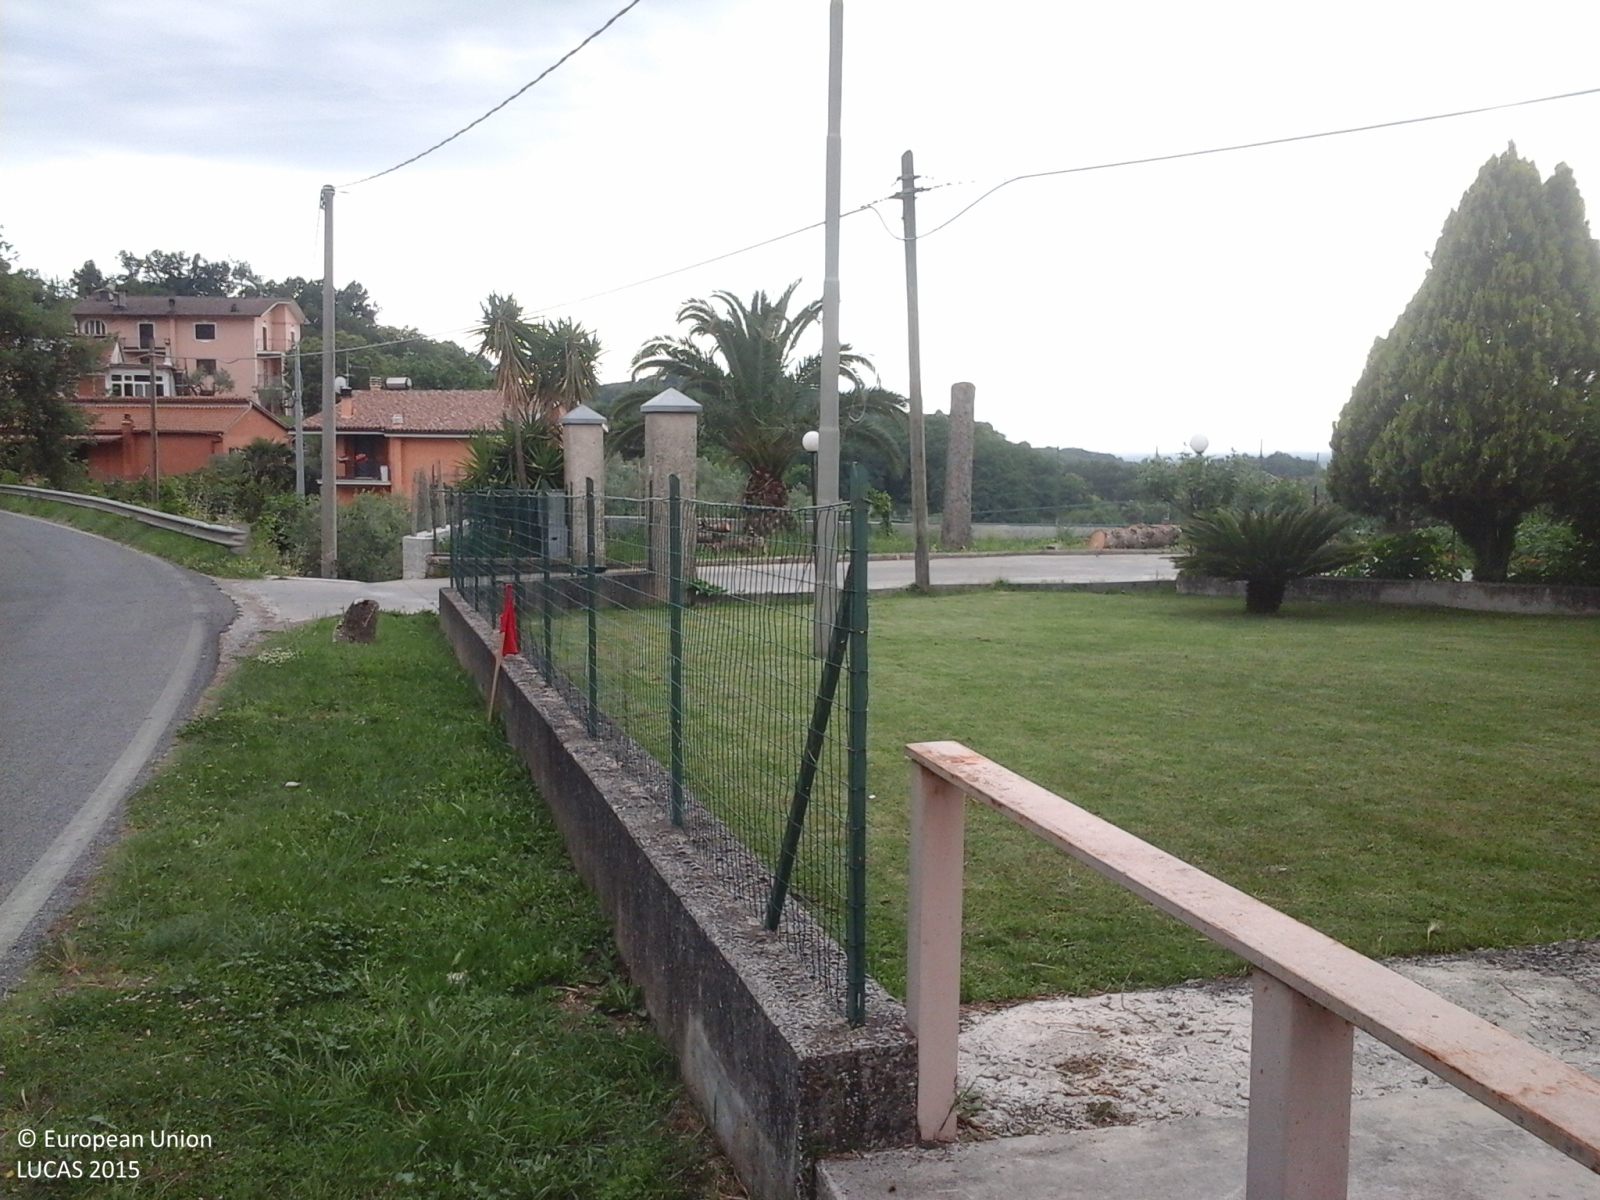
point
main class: Grassland
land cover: Grassland without tree/shrub cover
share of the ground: > 75 %
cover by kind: herbaceous plants 100 %
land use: Residential
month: June
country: IT
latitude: 41.8297
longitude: 13.0831
